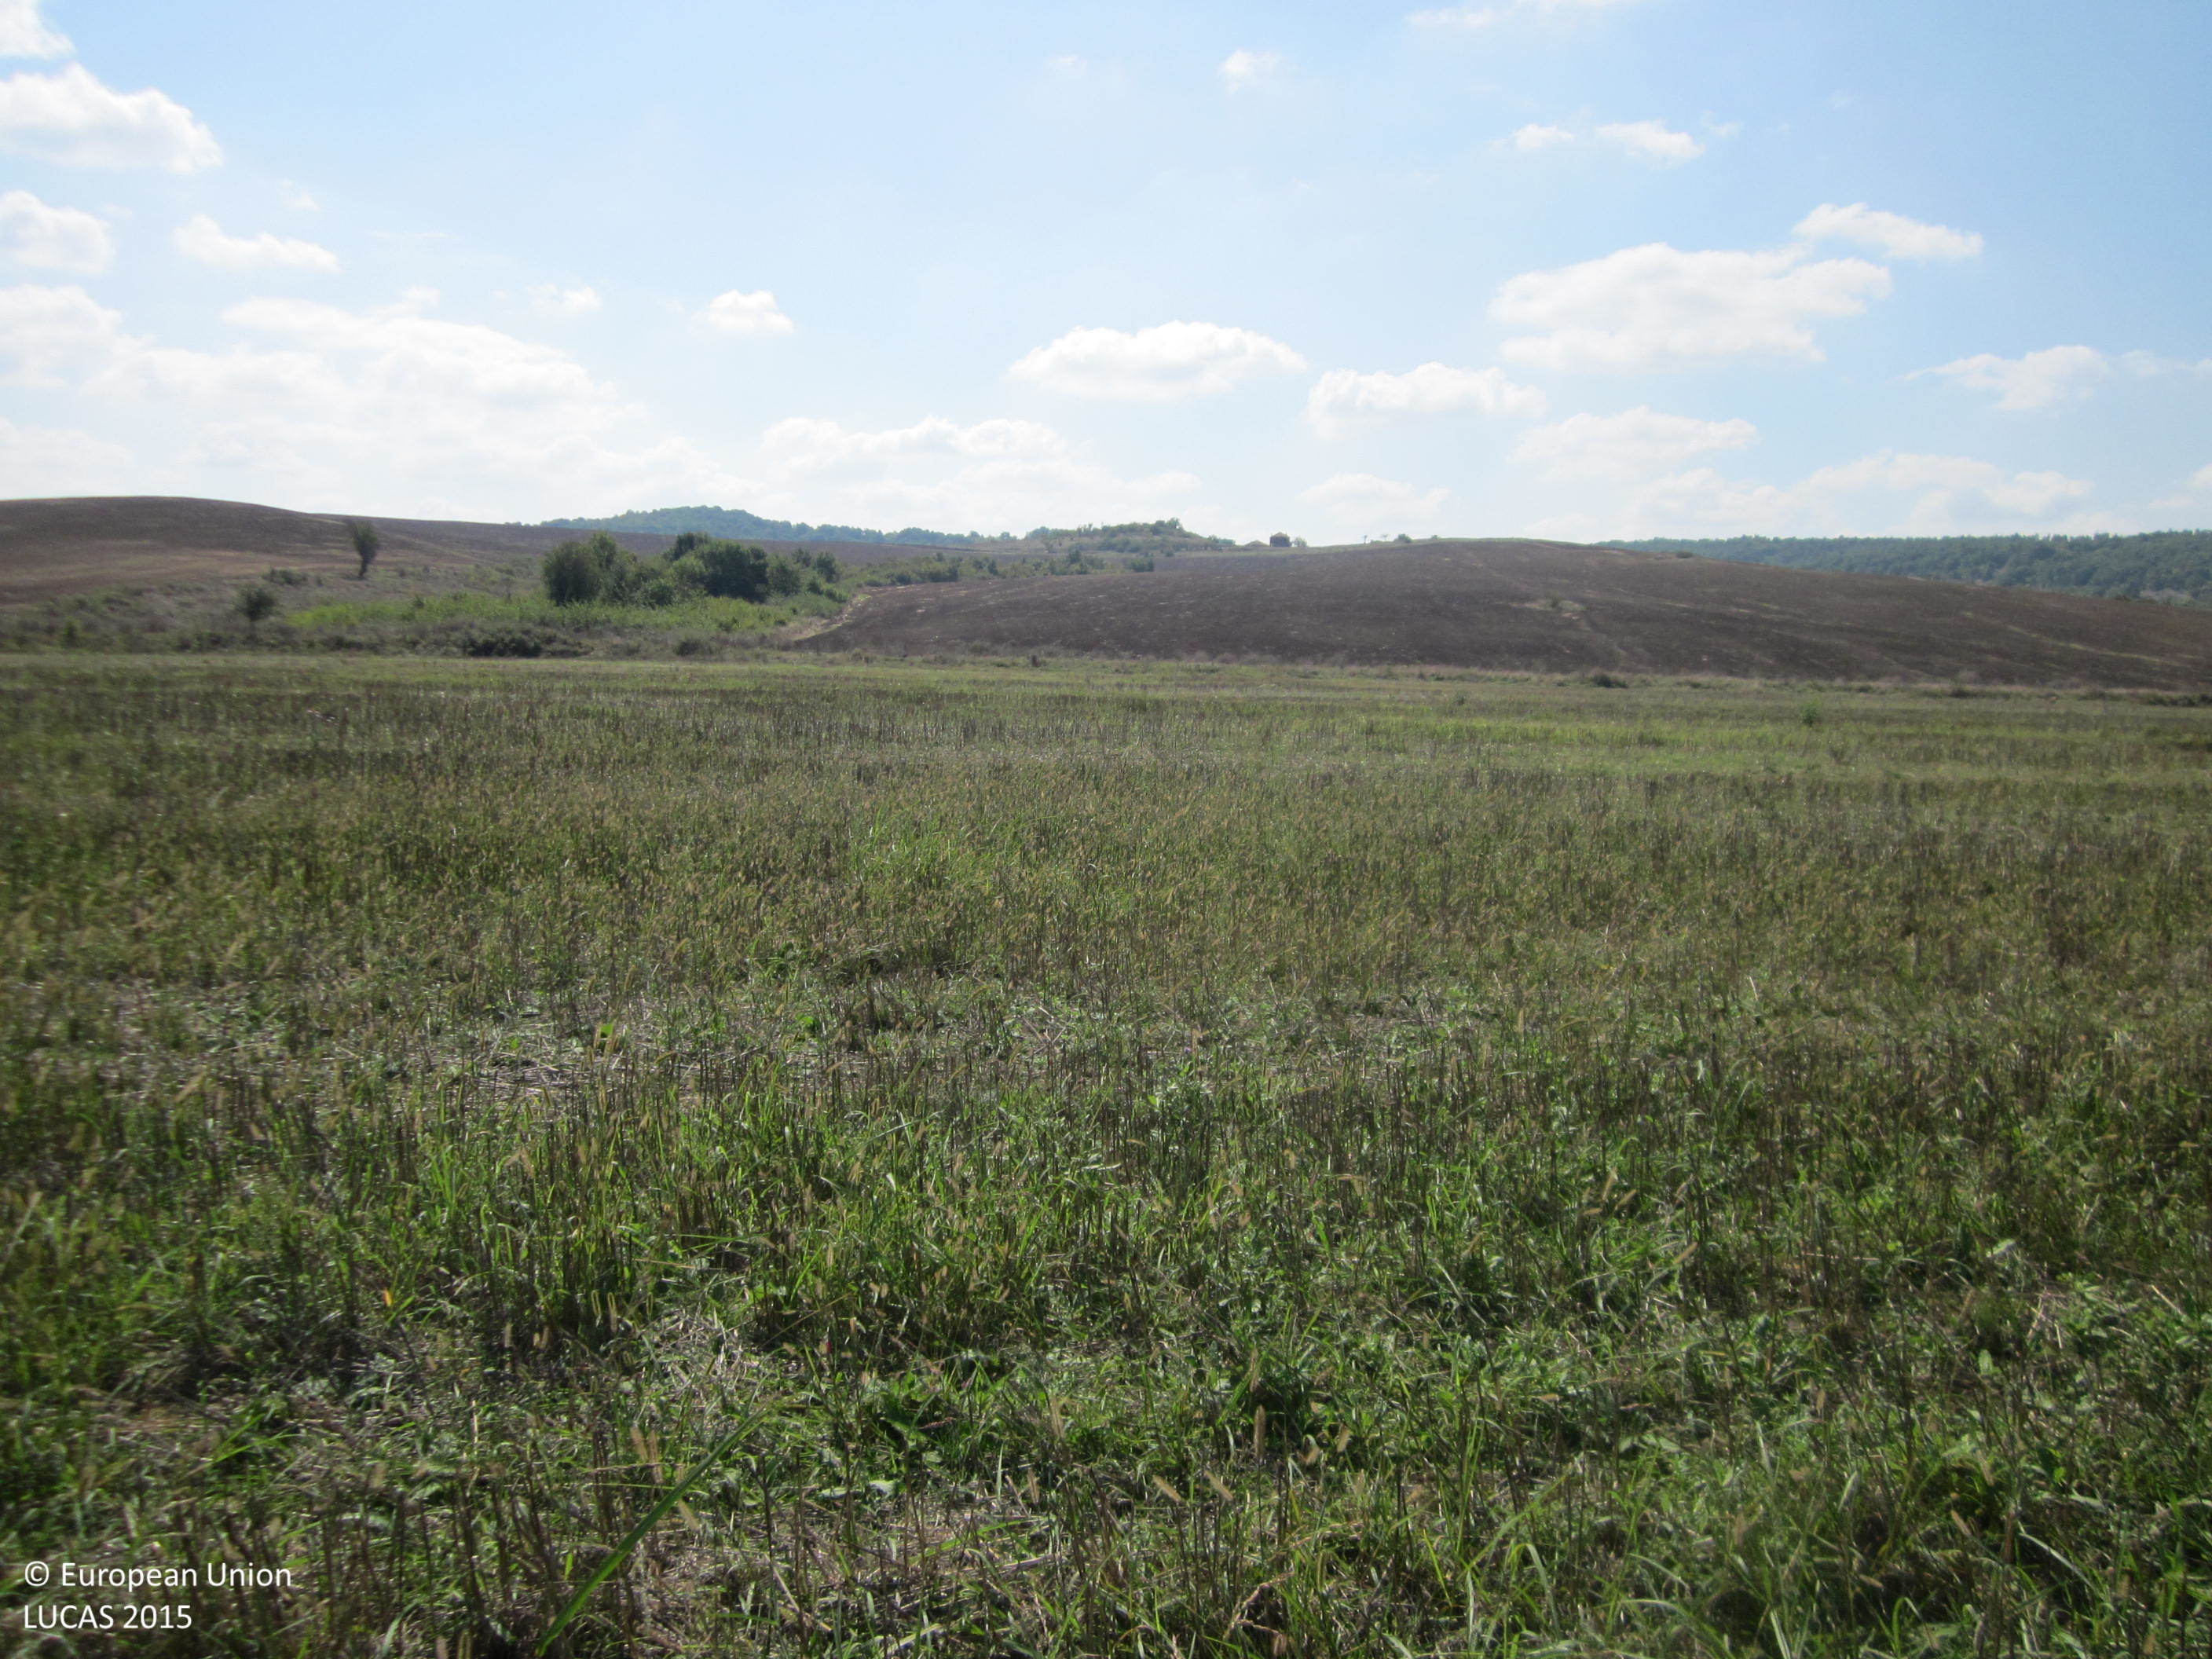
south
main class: Cropland
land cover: Maize
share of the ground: > 75 %
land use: Agriculture (excluding fallow land and kitchen gardens)
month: September
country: BG
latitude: 42.3219
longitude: 27.3540
